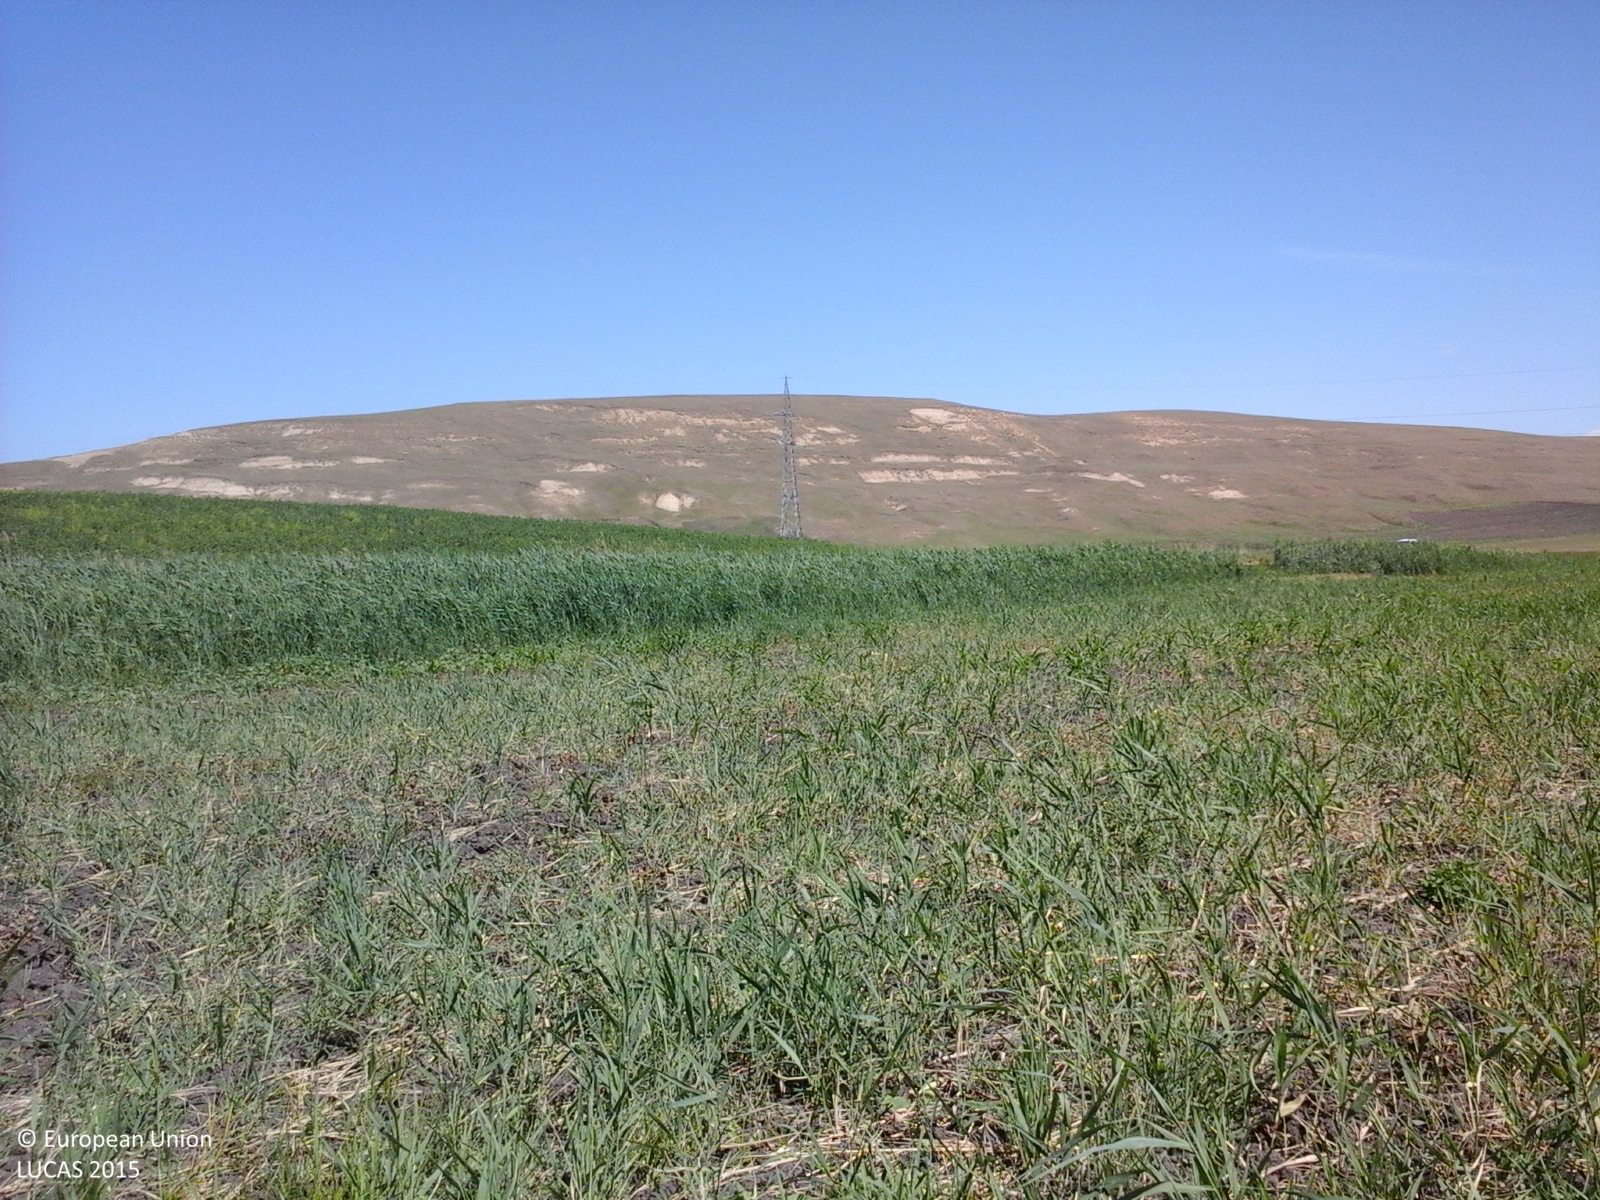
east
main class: Grassland
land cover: Spontaneously vegetated surfaces
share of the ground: > 75 %
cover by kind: herbaceous plants 100 %
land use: Agriculture (excluding fallow land and kitchen gardens)
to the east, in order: Spontaneously vegetated surfaces; Inland marshes; Grass margins; Tracks; Grass margins; Inland marshes; Inland fresh running water; Grassland without tree/shrub cover; Electric lines; Grassland without tree/shrub cover
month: June
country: RO
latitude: 47.2533
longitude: 27.0289
